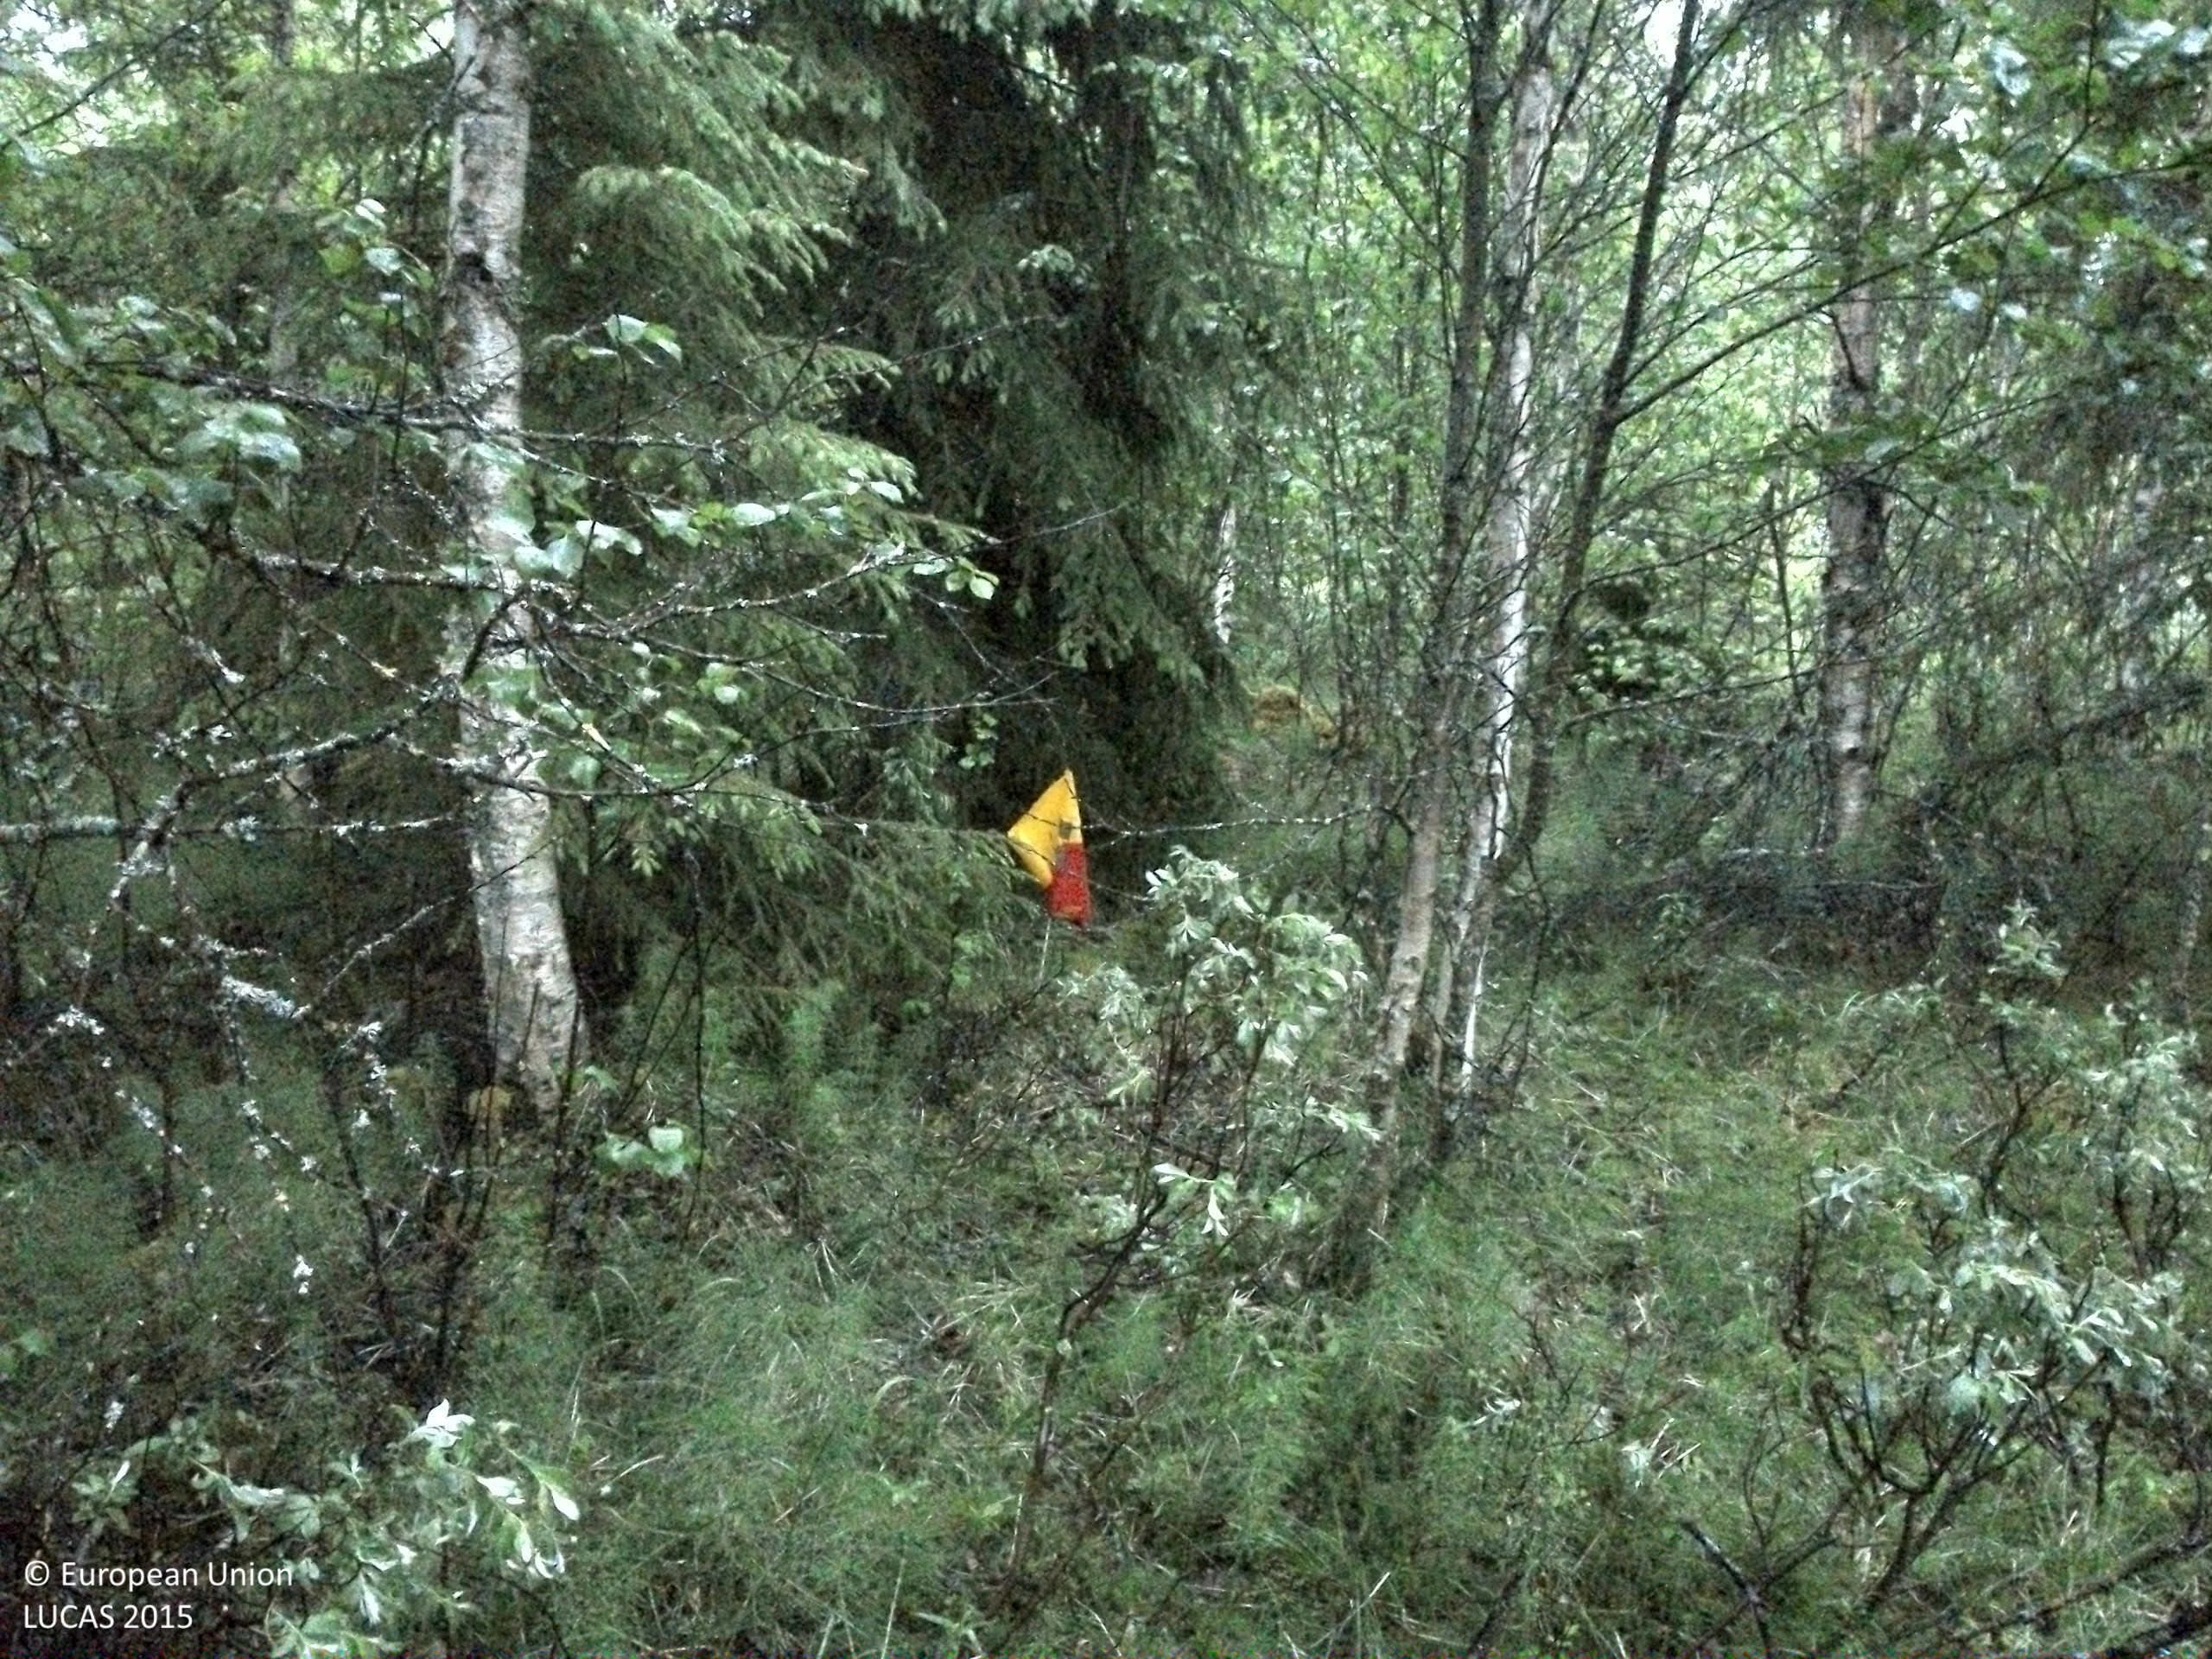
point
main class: Woodland
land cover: Other mixed woodland
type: boreal forest
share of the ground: > 75 %
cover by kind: broadleaved forest trees 45 %, coniferous forest trees 40 %, herbaceous plants 10 %, lichens and mosses 5 %
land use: Forestry
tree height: > 5 m
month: July
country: SE
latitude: 64.4784
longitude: 16.1468
